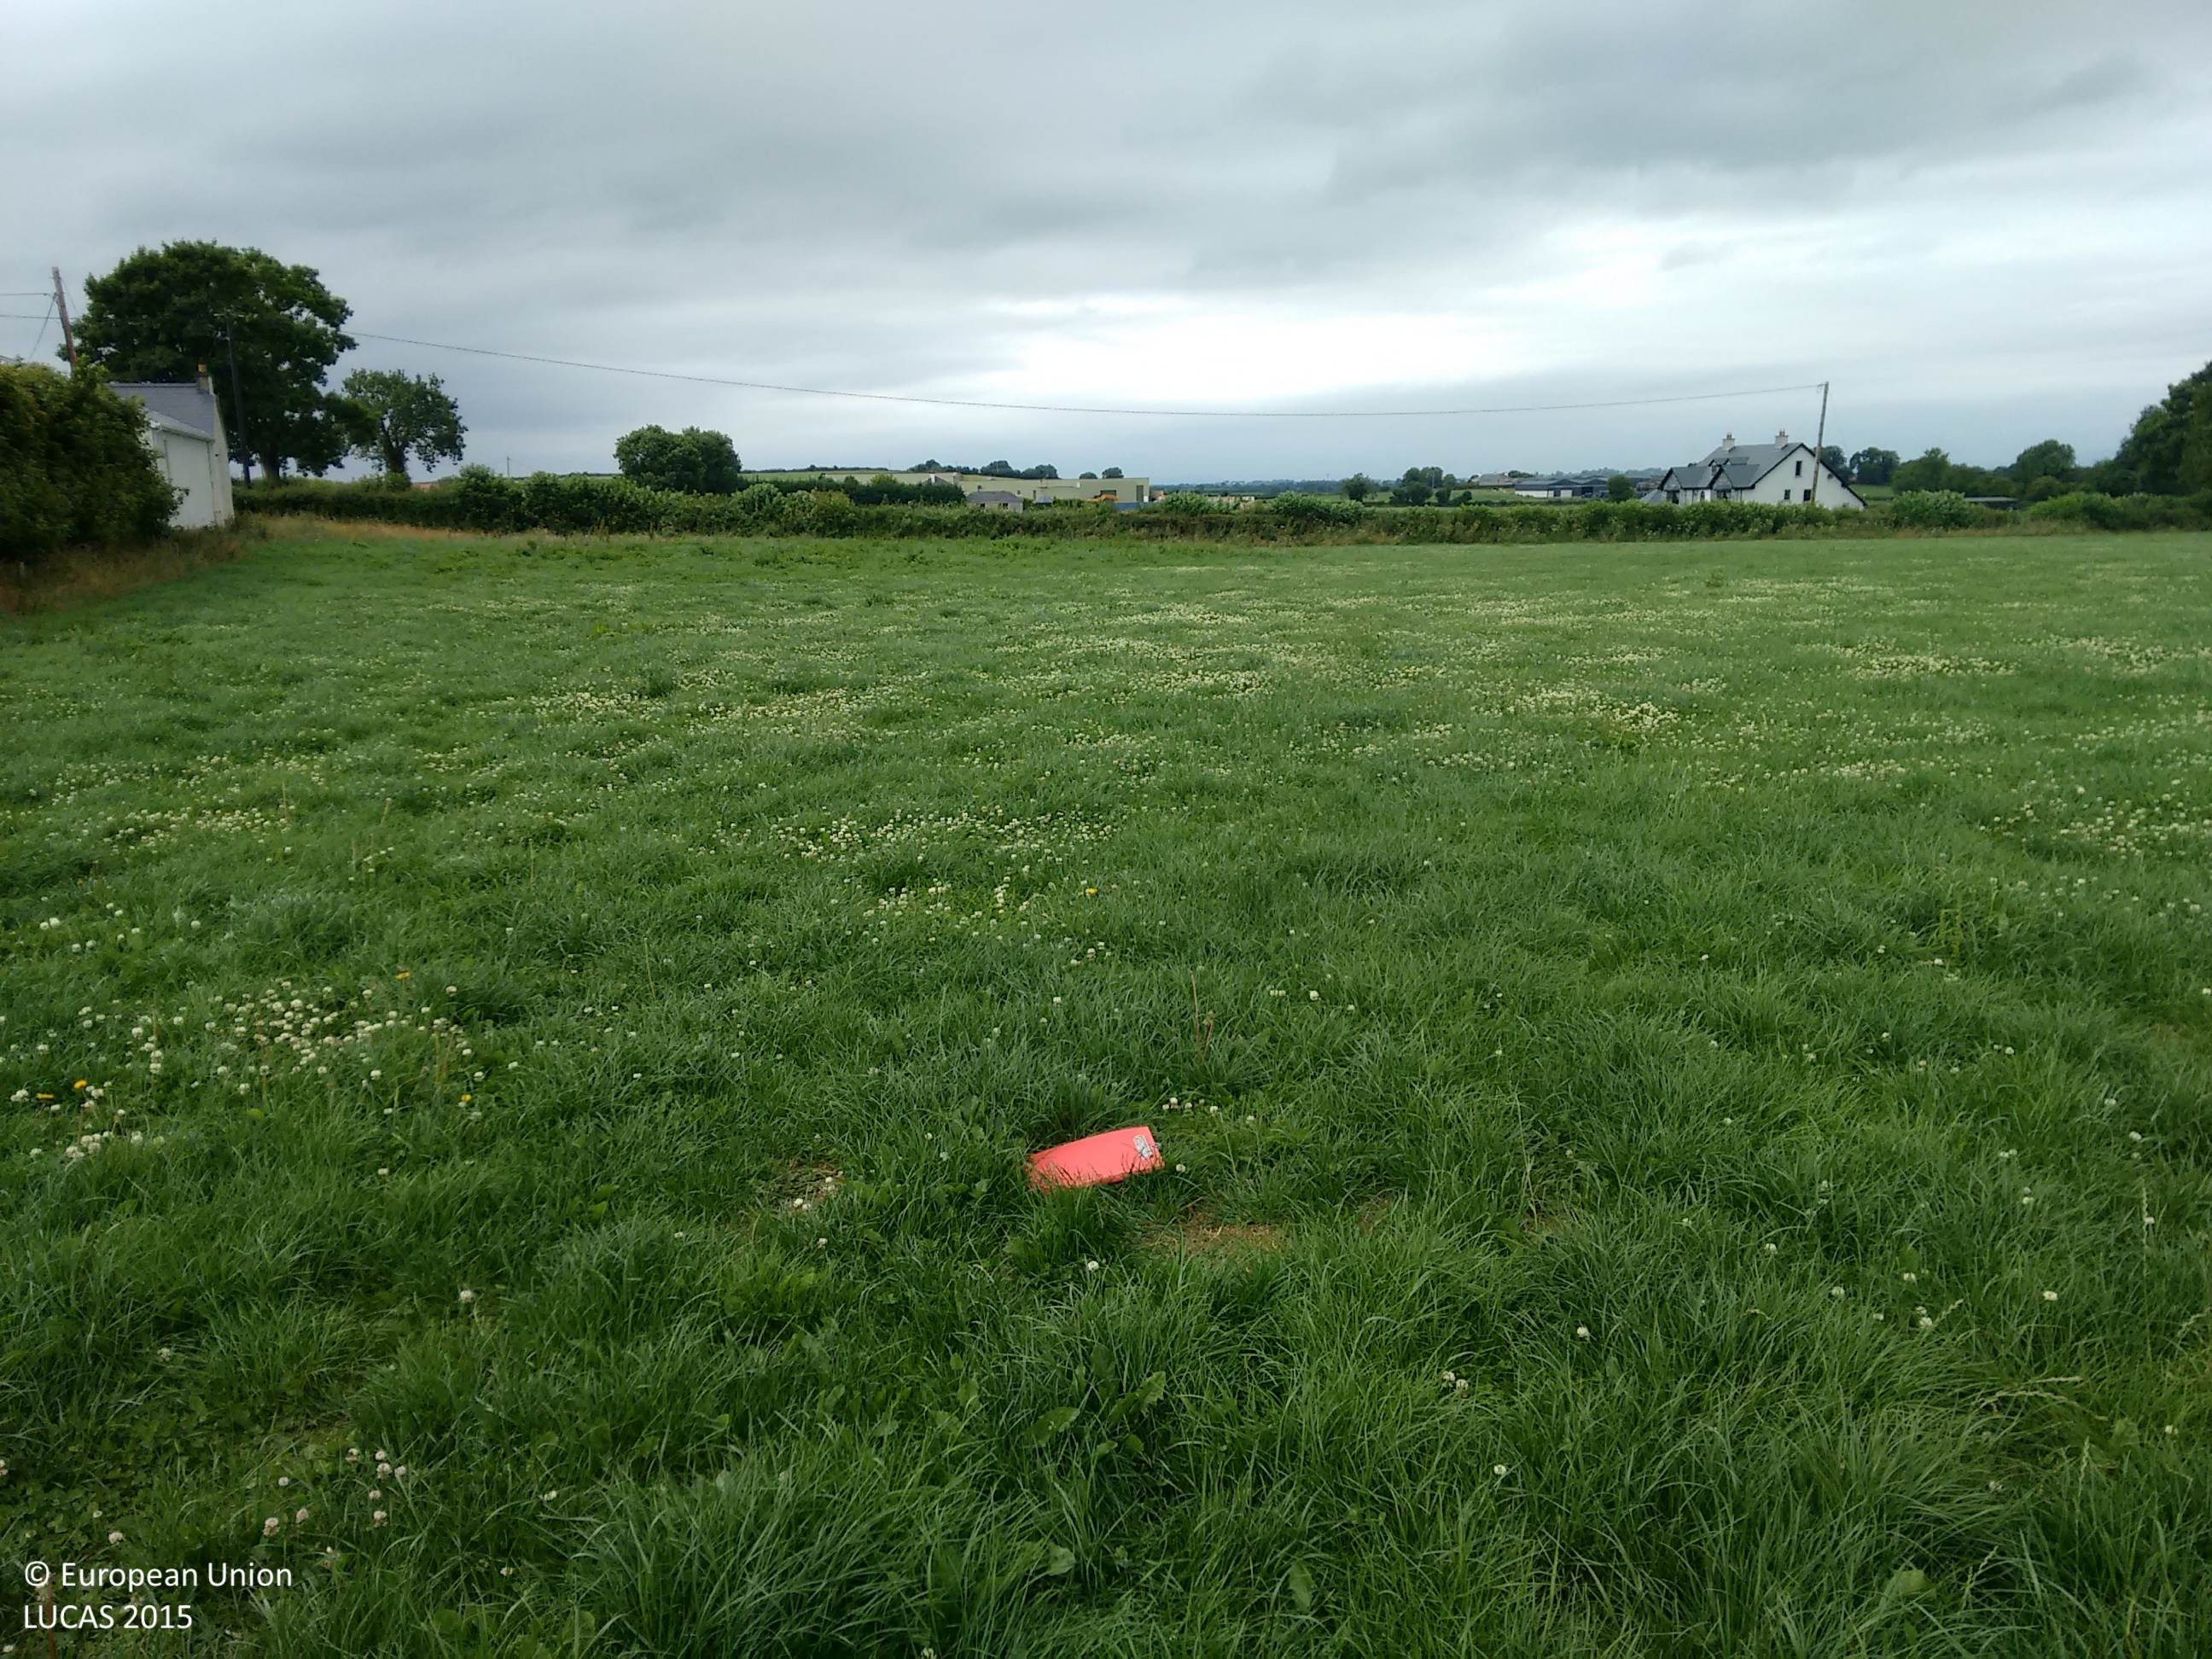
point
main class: Grassland
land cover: Grassland without tree/shrub cover
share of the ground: > 75 %
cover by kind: herbaceous plants 95 %, unconsolidated bare surface 5 %
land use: Agriculture (excluding fallow land and kitchen gardens)
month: July
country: IE
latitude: 52.6996
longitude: -7.5175
